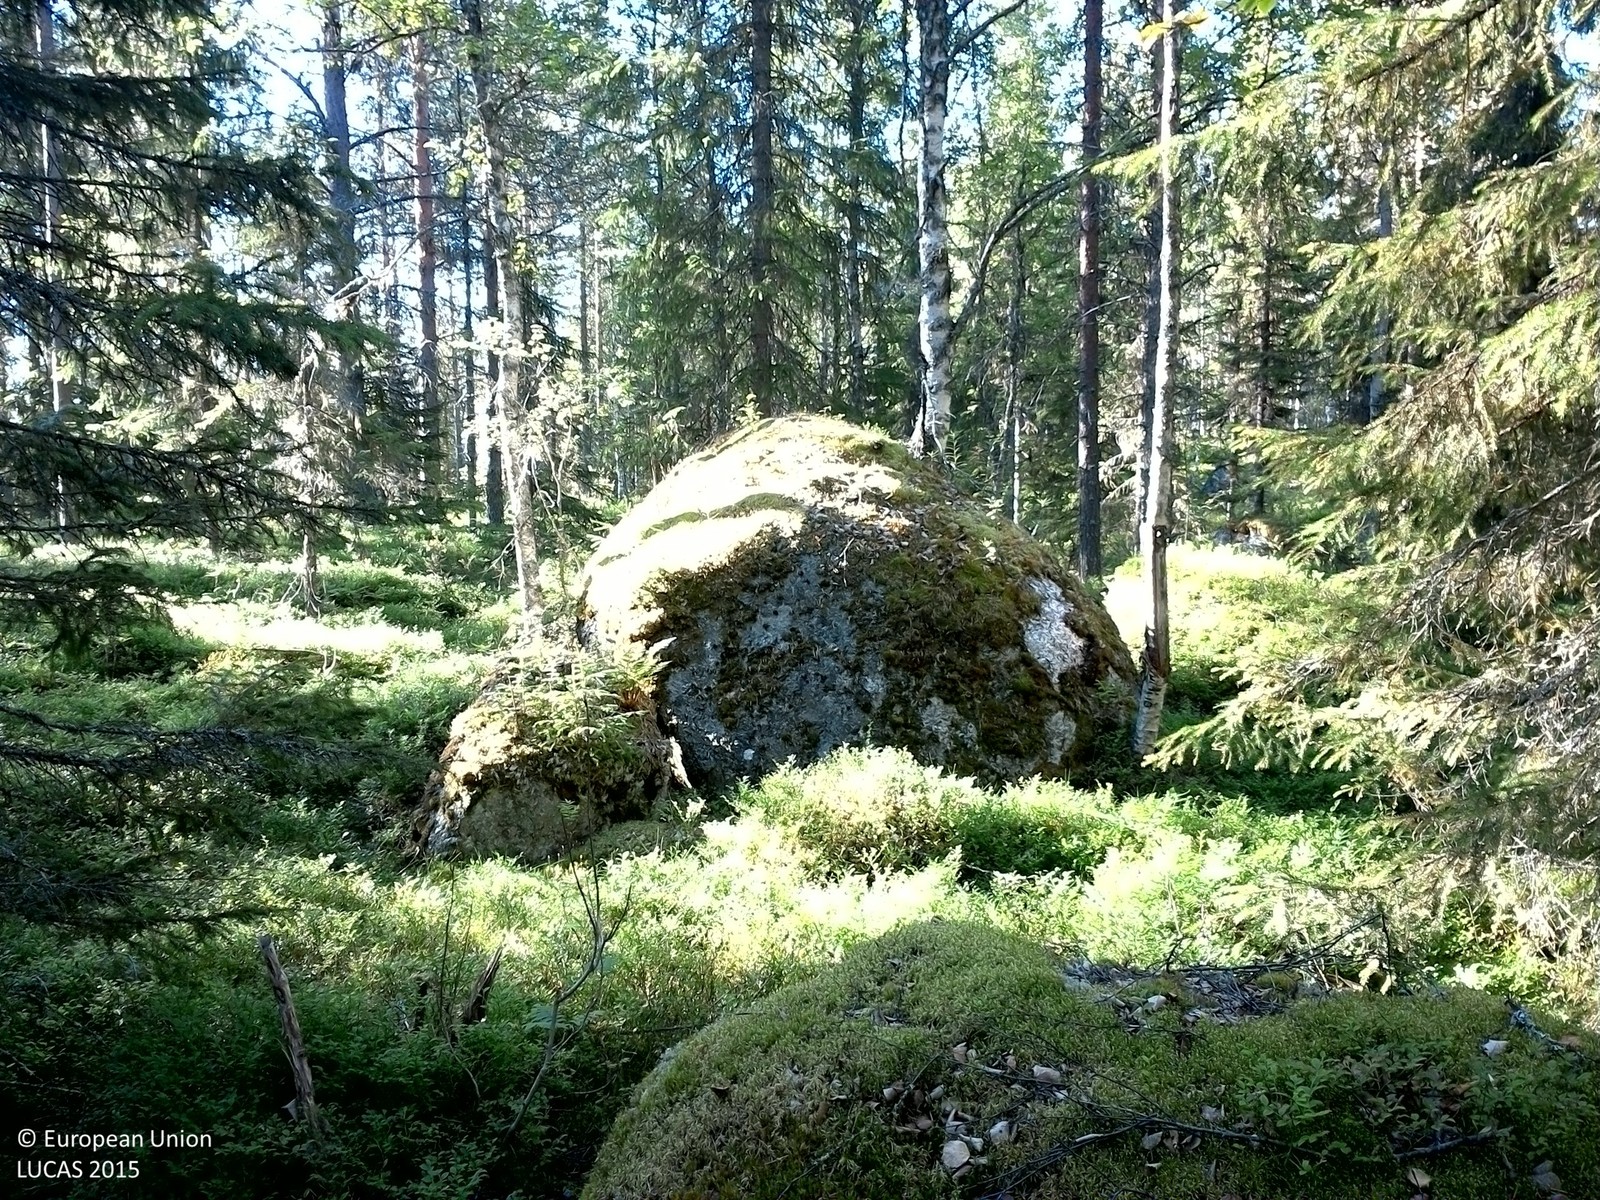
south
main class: Woodland
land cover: Other coniferous woodland
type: boreal forest
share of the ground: 50 - 75 %
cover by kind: coniferous forest trees 55 %, shrubs 20 %, broadleaved forest trees 10 %, lichens and mosses 10 %, consolidated bare surface 5 %
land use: Forestry
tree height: > 5 m
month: August
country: SE
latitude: 64.0371
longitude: 16.7470
